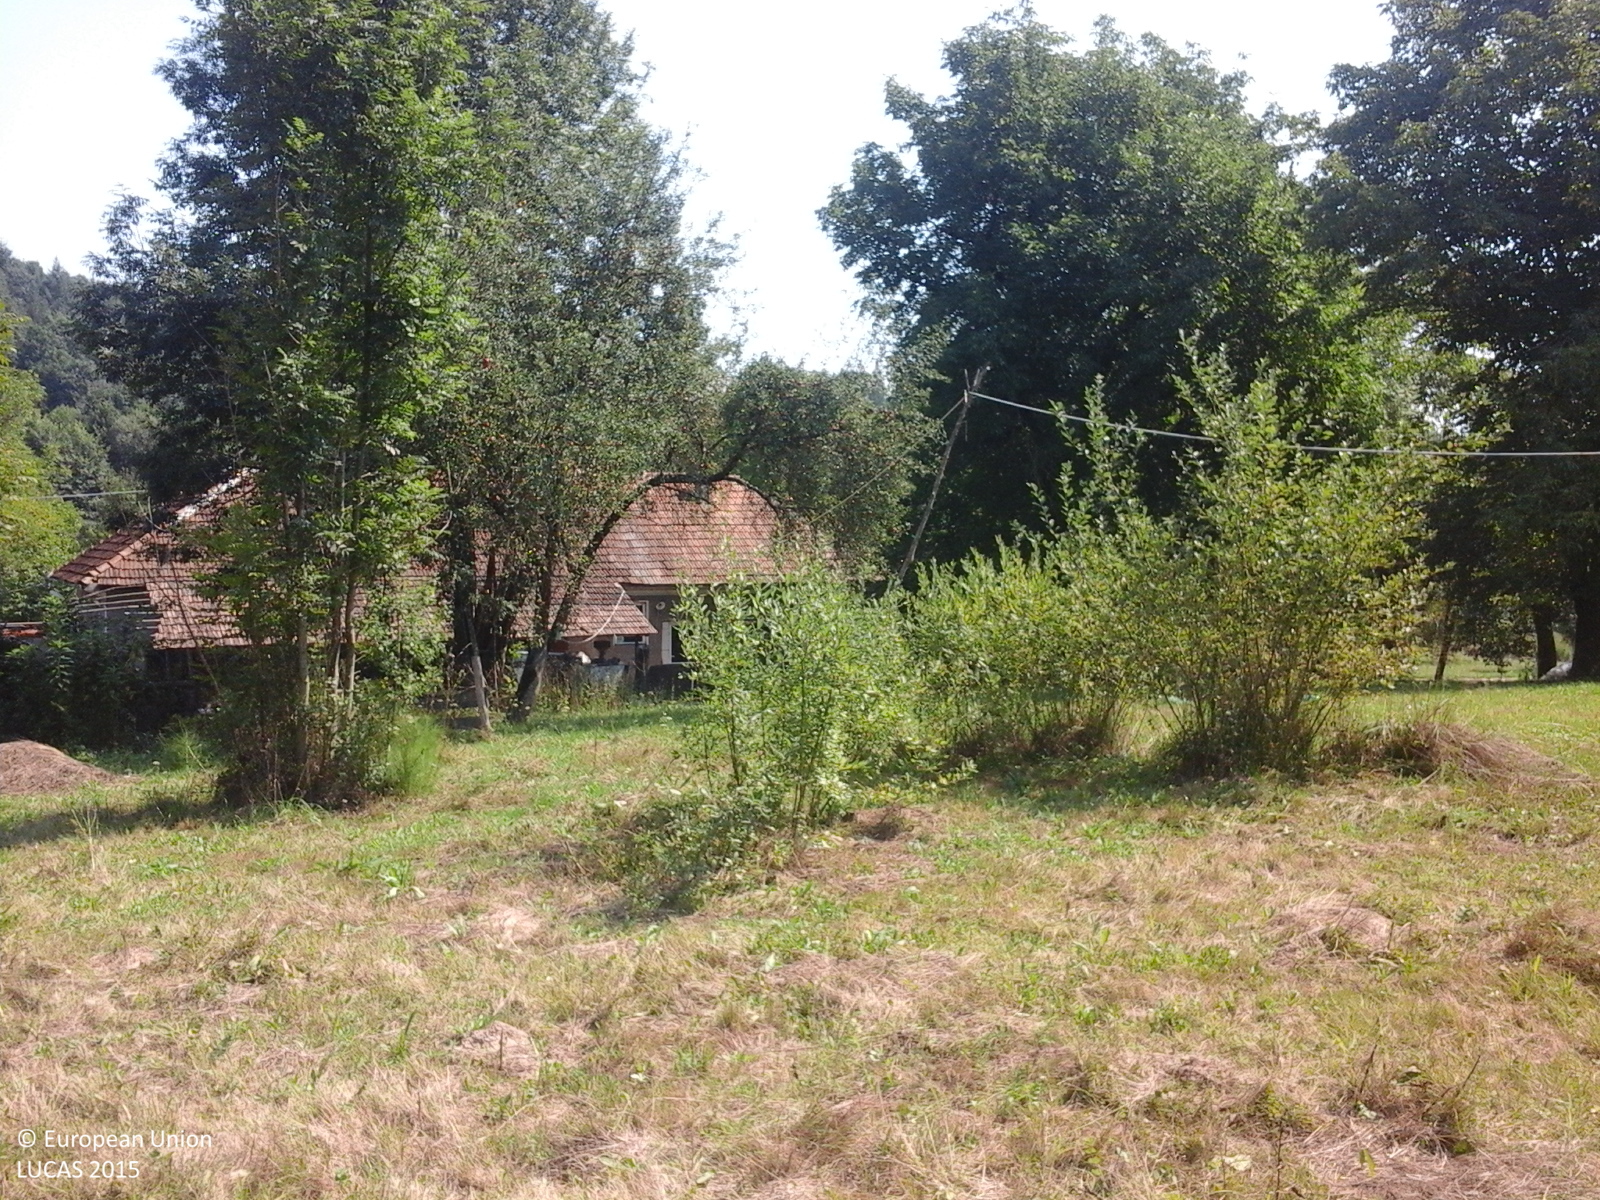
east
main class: Grassland
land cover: Grassland without tree/shrub cover
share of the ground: > 75 %
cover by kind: herbaceous plants 100 %
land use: Agriculture (excluding fallow land and kitchen gardens)
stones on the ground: < 10 %
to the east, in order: Grassland without tree/shrub cover; Broadleaved woodland; Artificial constructions in urban areas; Other fruit trees and berries; Grass margins; Inland fresh water bodies; Grass margins; Broadleaved woodland
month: August
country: RO
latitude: 46.3420
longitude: 22.5107
